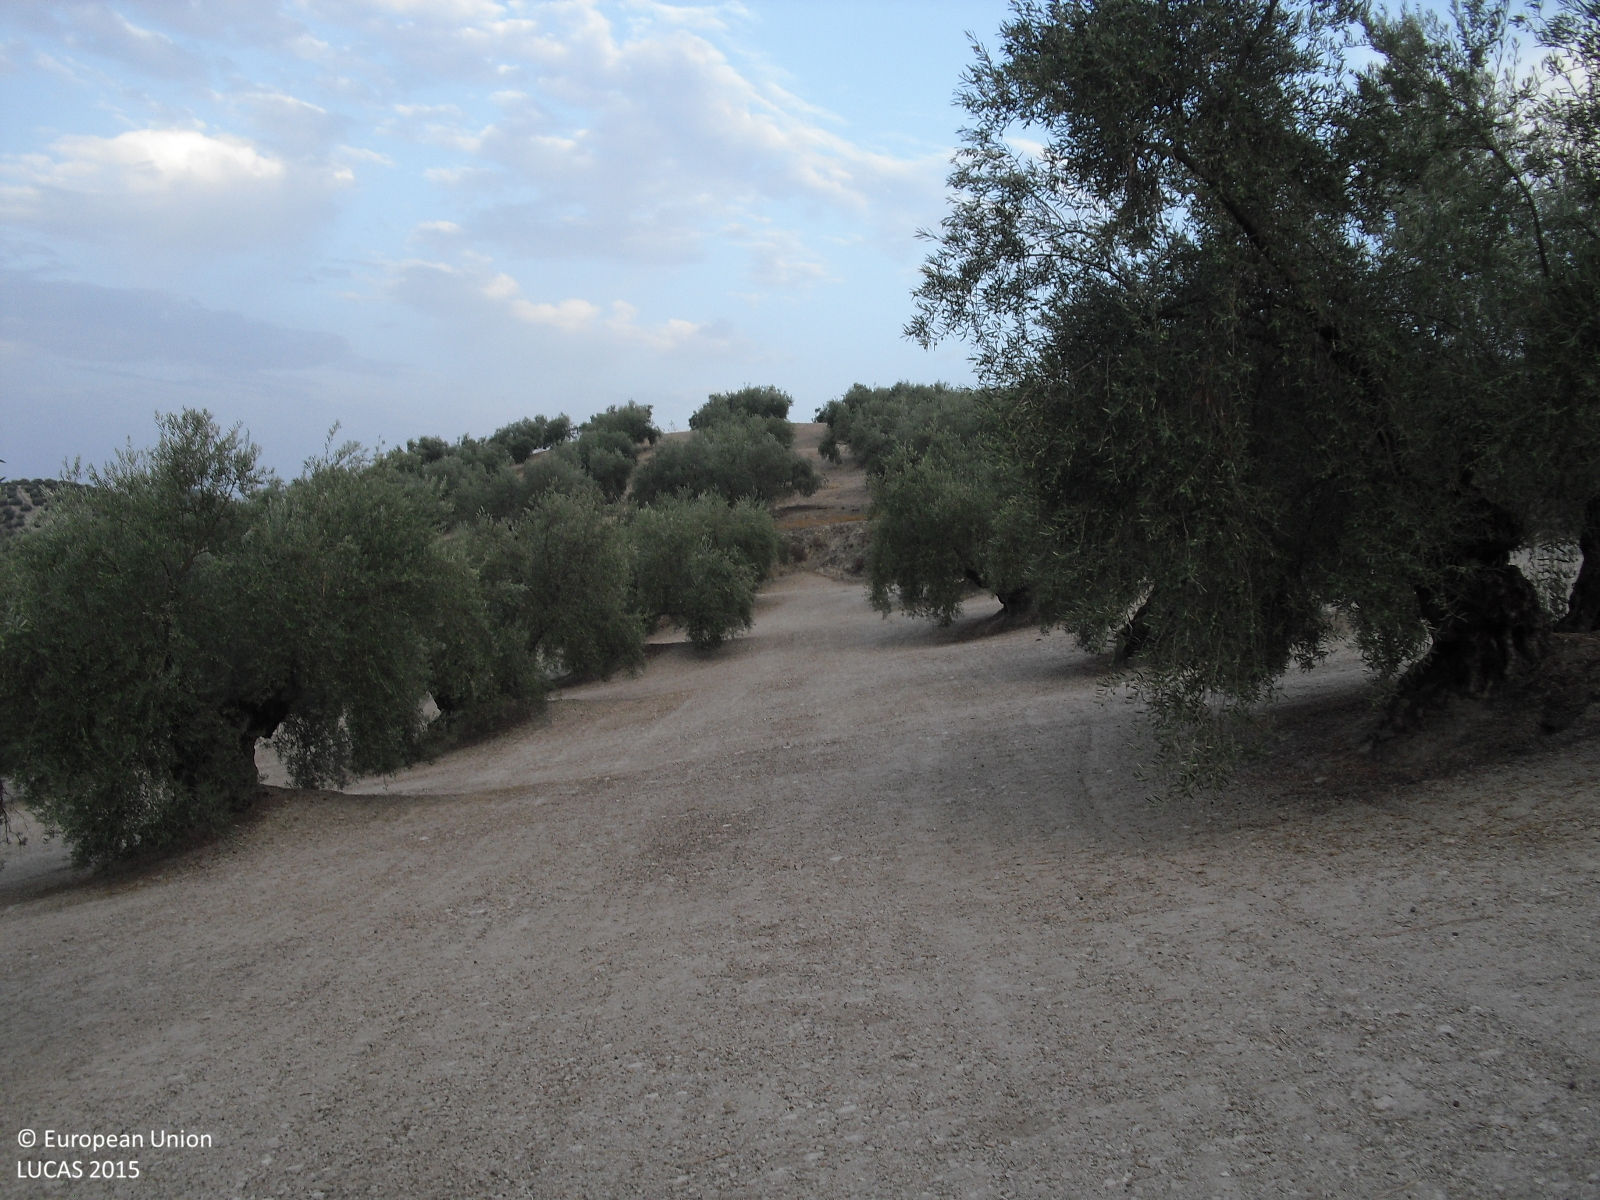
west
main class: Cropland
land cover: Olive groves
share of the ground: 25 - 50 %
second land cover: Other bare soil
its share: > 75 %
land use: Agriculture (excluding fallow land and kitchen gardens)
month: August
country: ES
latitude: 37.2984
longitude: -4.3374
